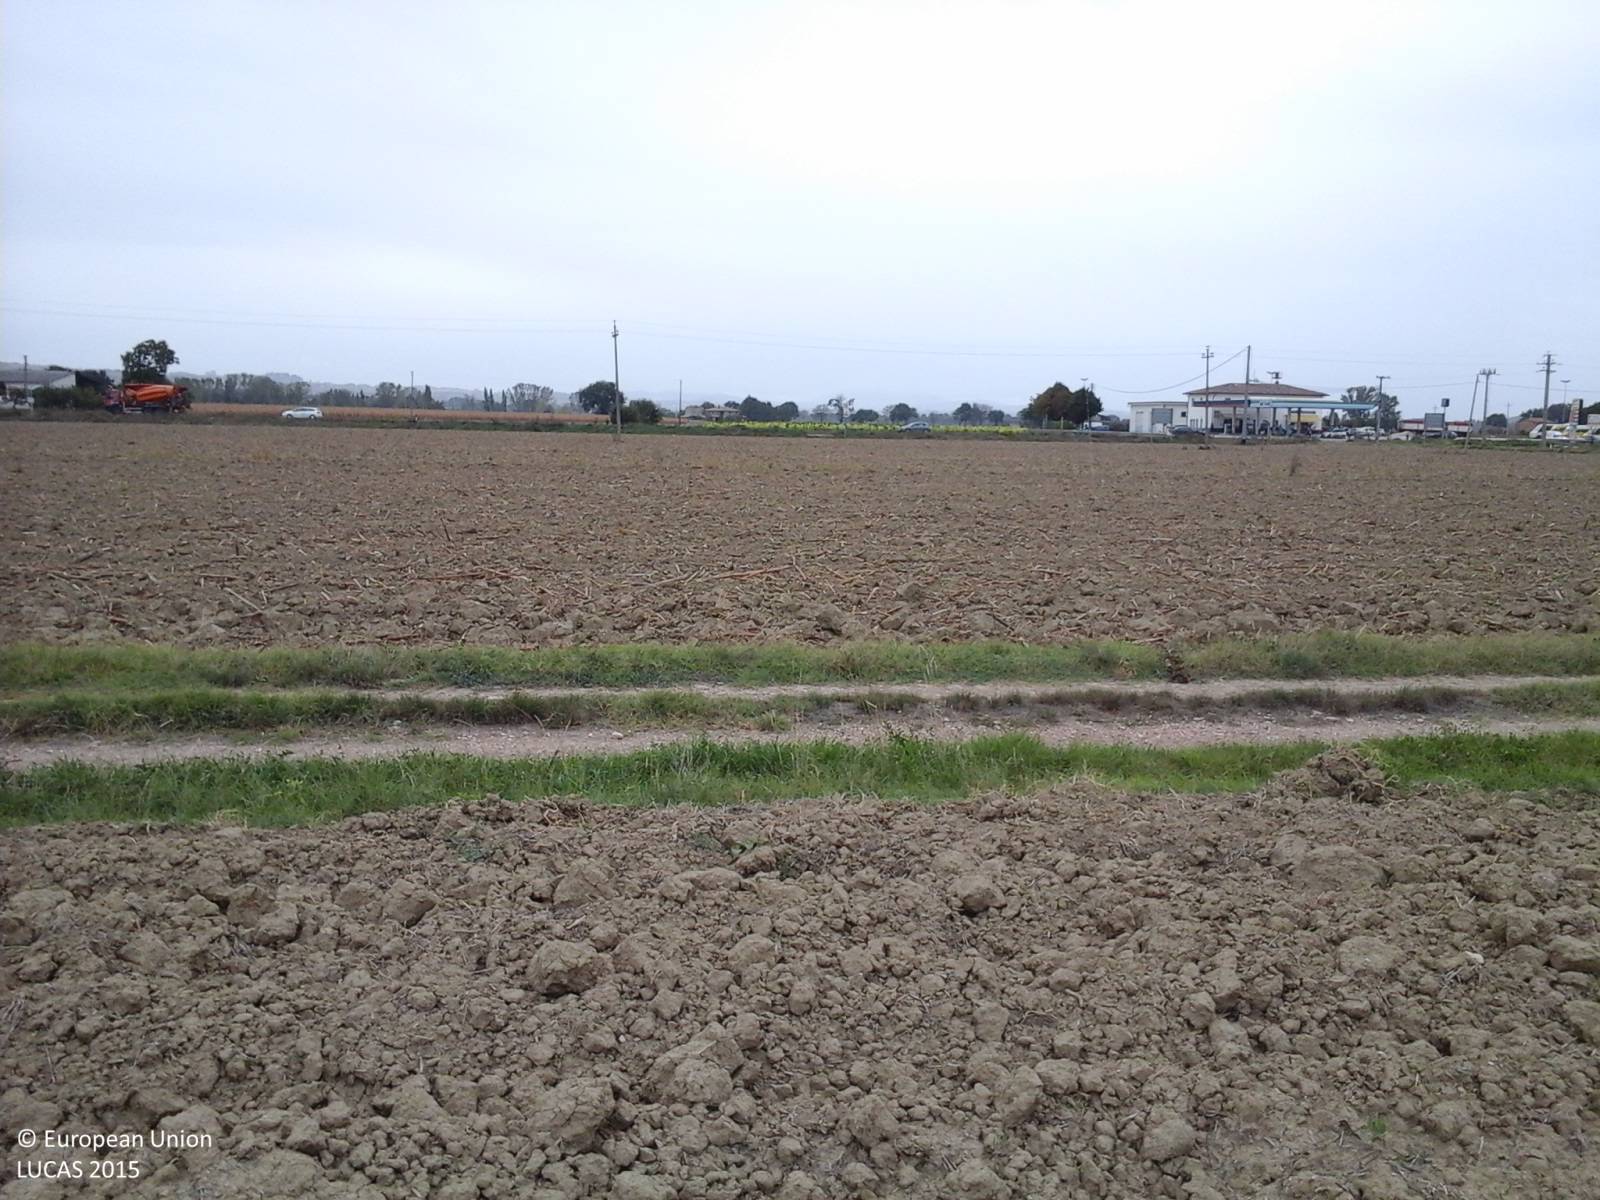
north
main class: Cropland
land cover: Sunflower
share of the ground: < 10 %
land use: Agriculture (excluding fallow land and kitchen gardens)
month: September
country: IT
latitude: 42.9151
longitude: 12.3815
